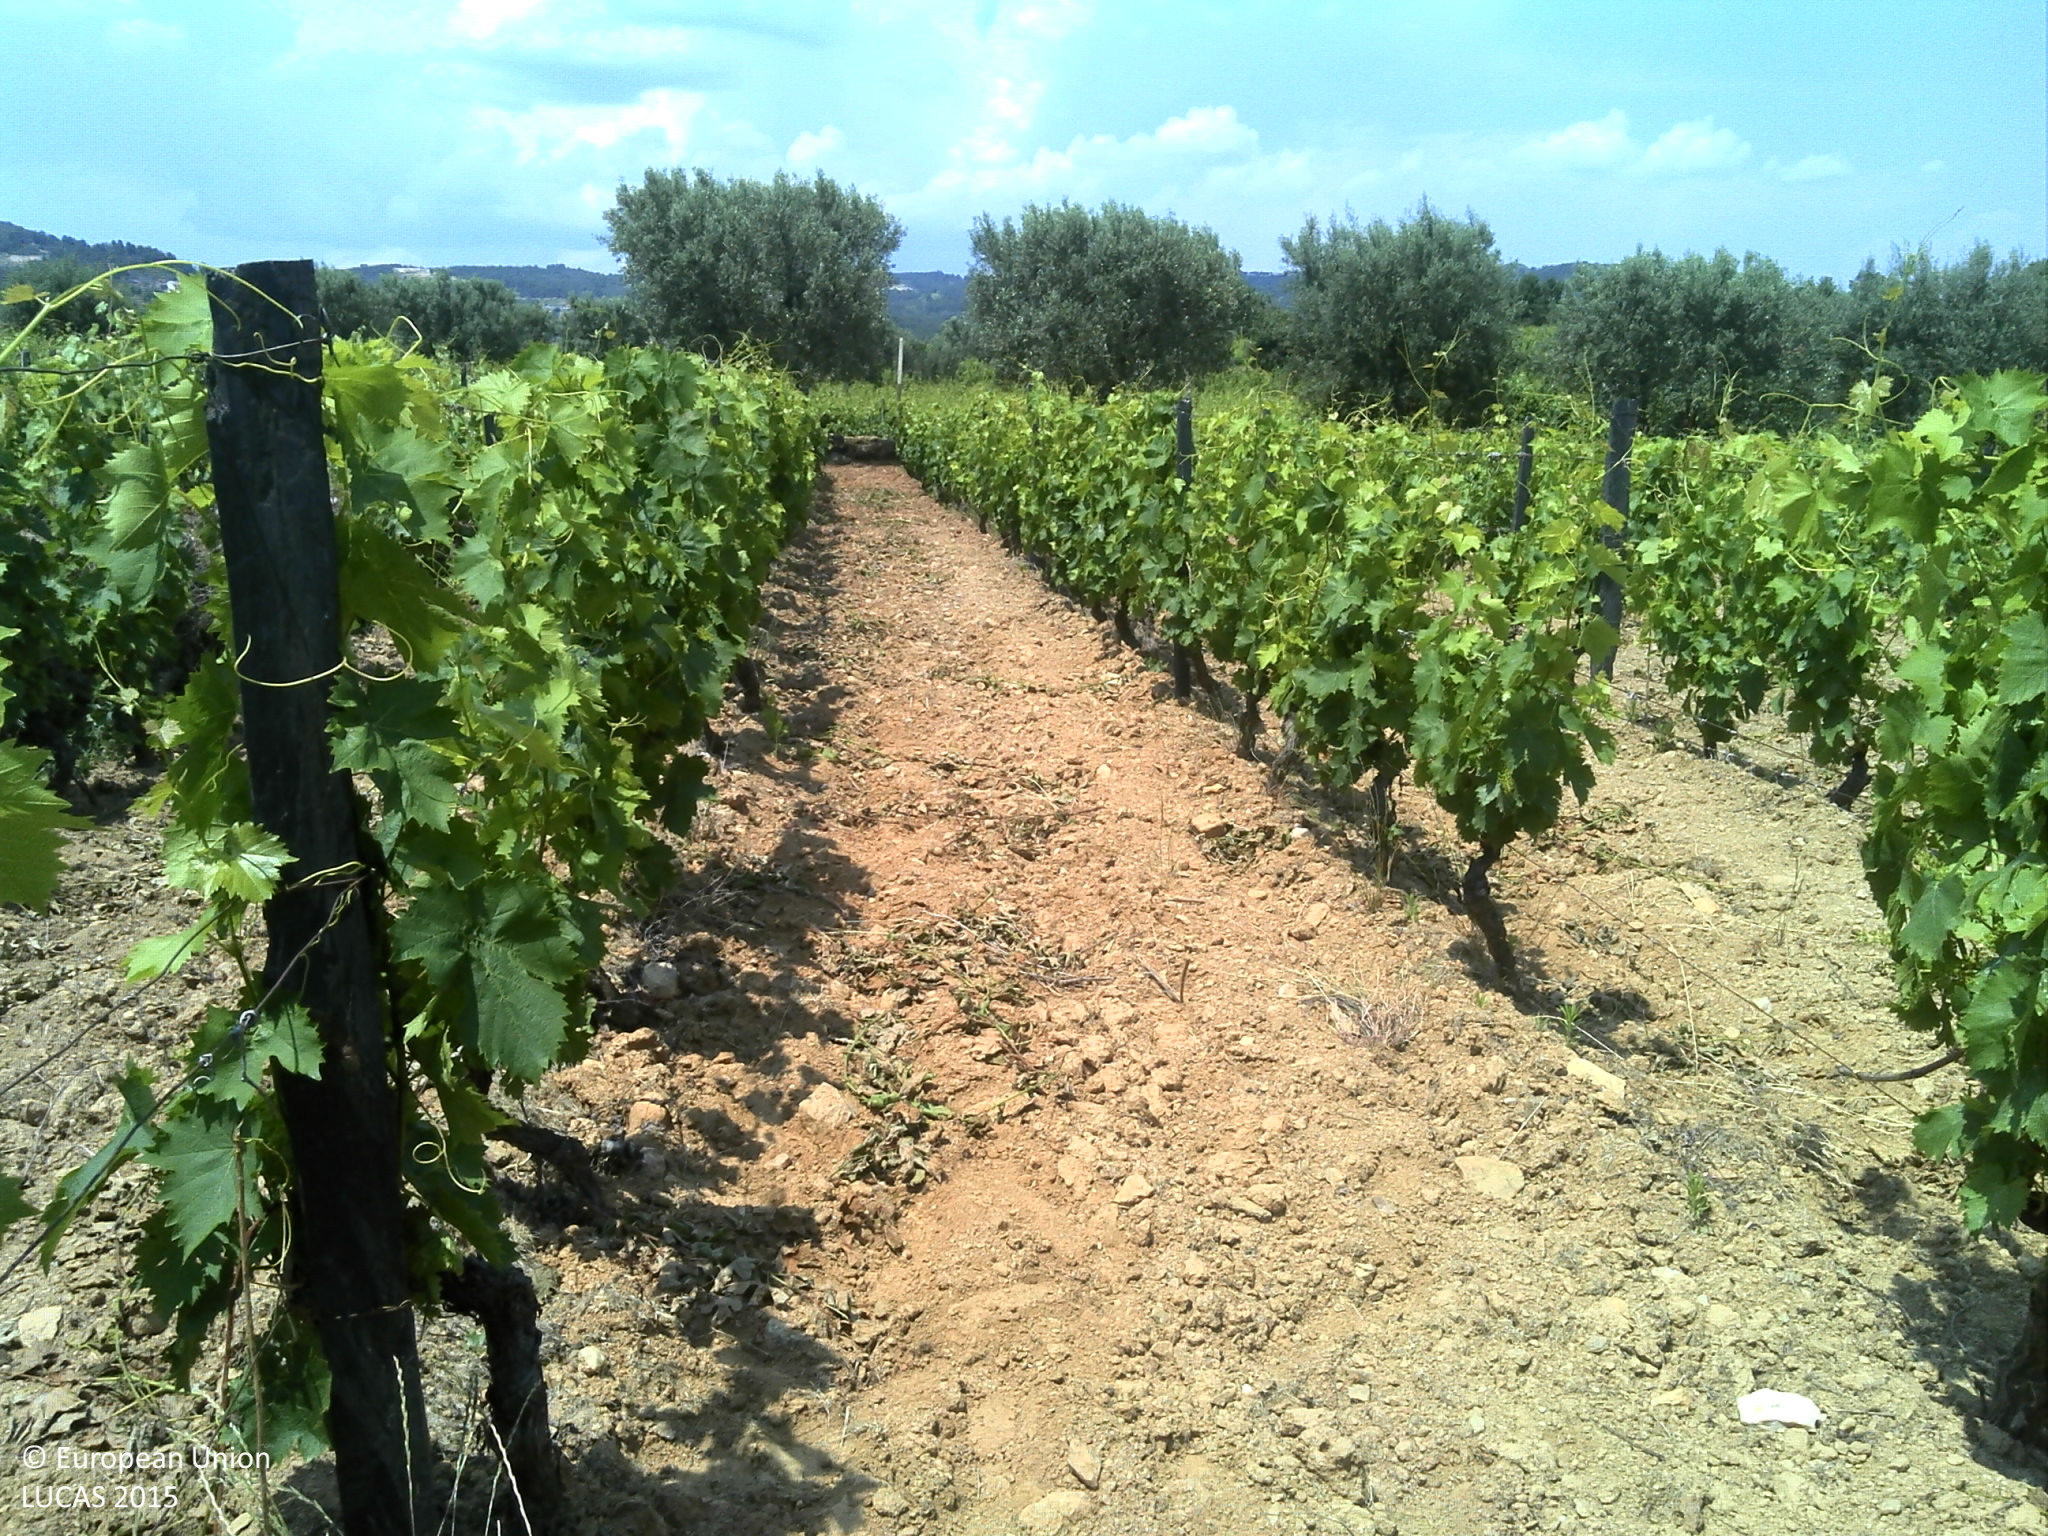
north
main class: Cropland
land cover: Vineyards
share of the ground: 10 - 25 %
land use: Agriculture (excluding fallow land and kitchen gardens)
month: June
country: PT
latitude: 41.2697
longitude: -7.4676
